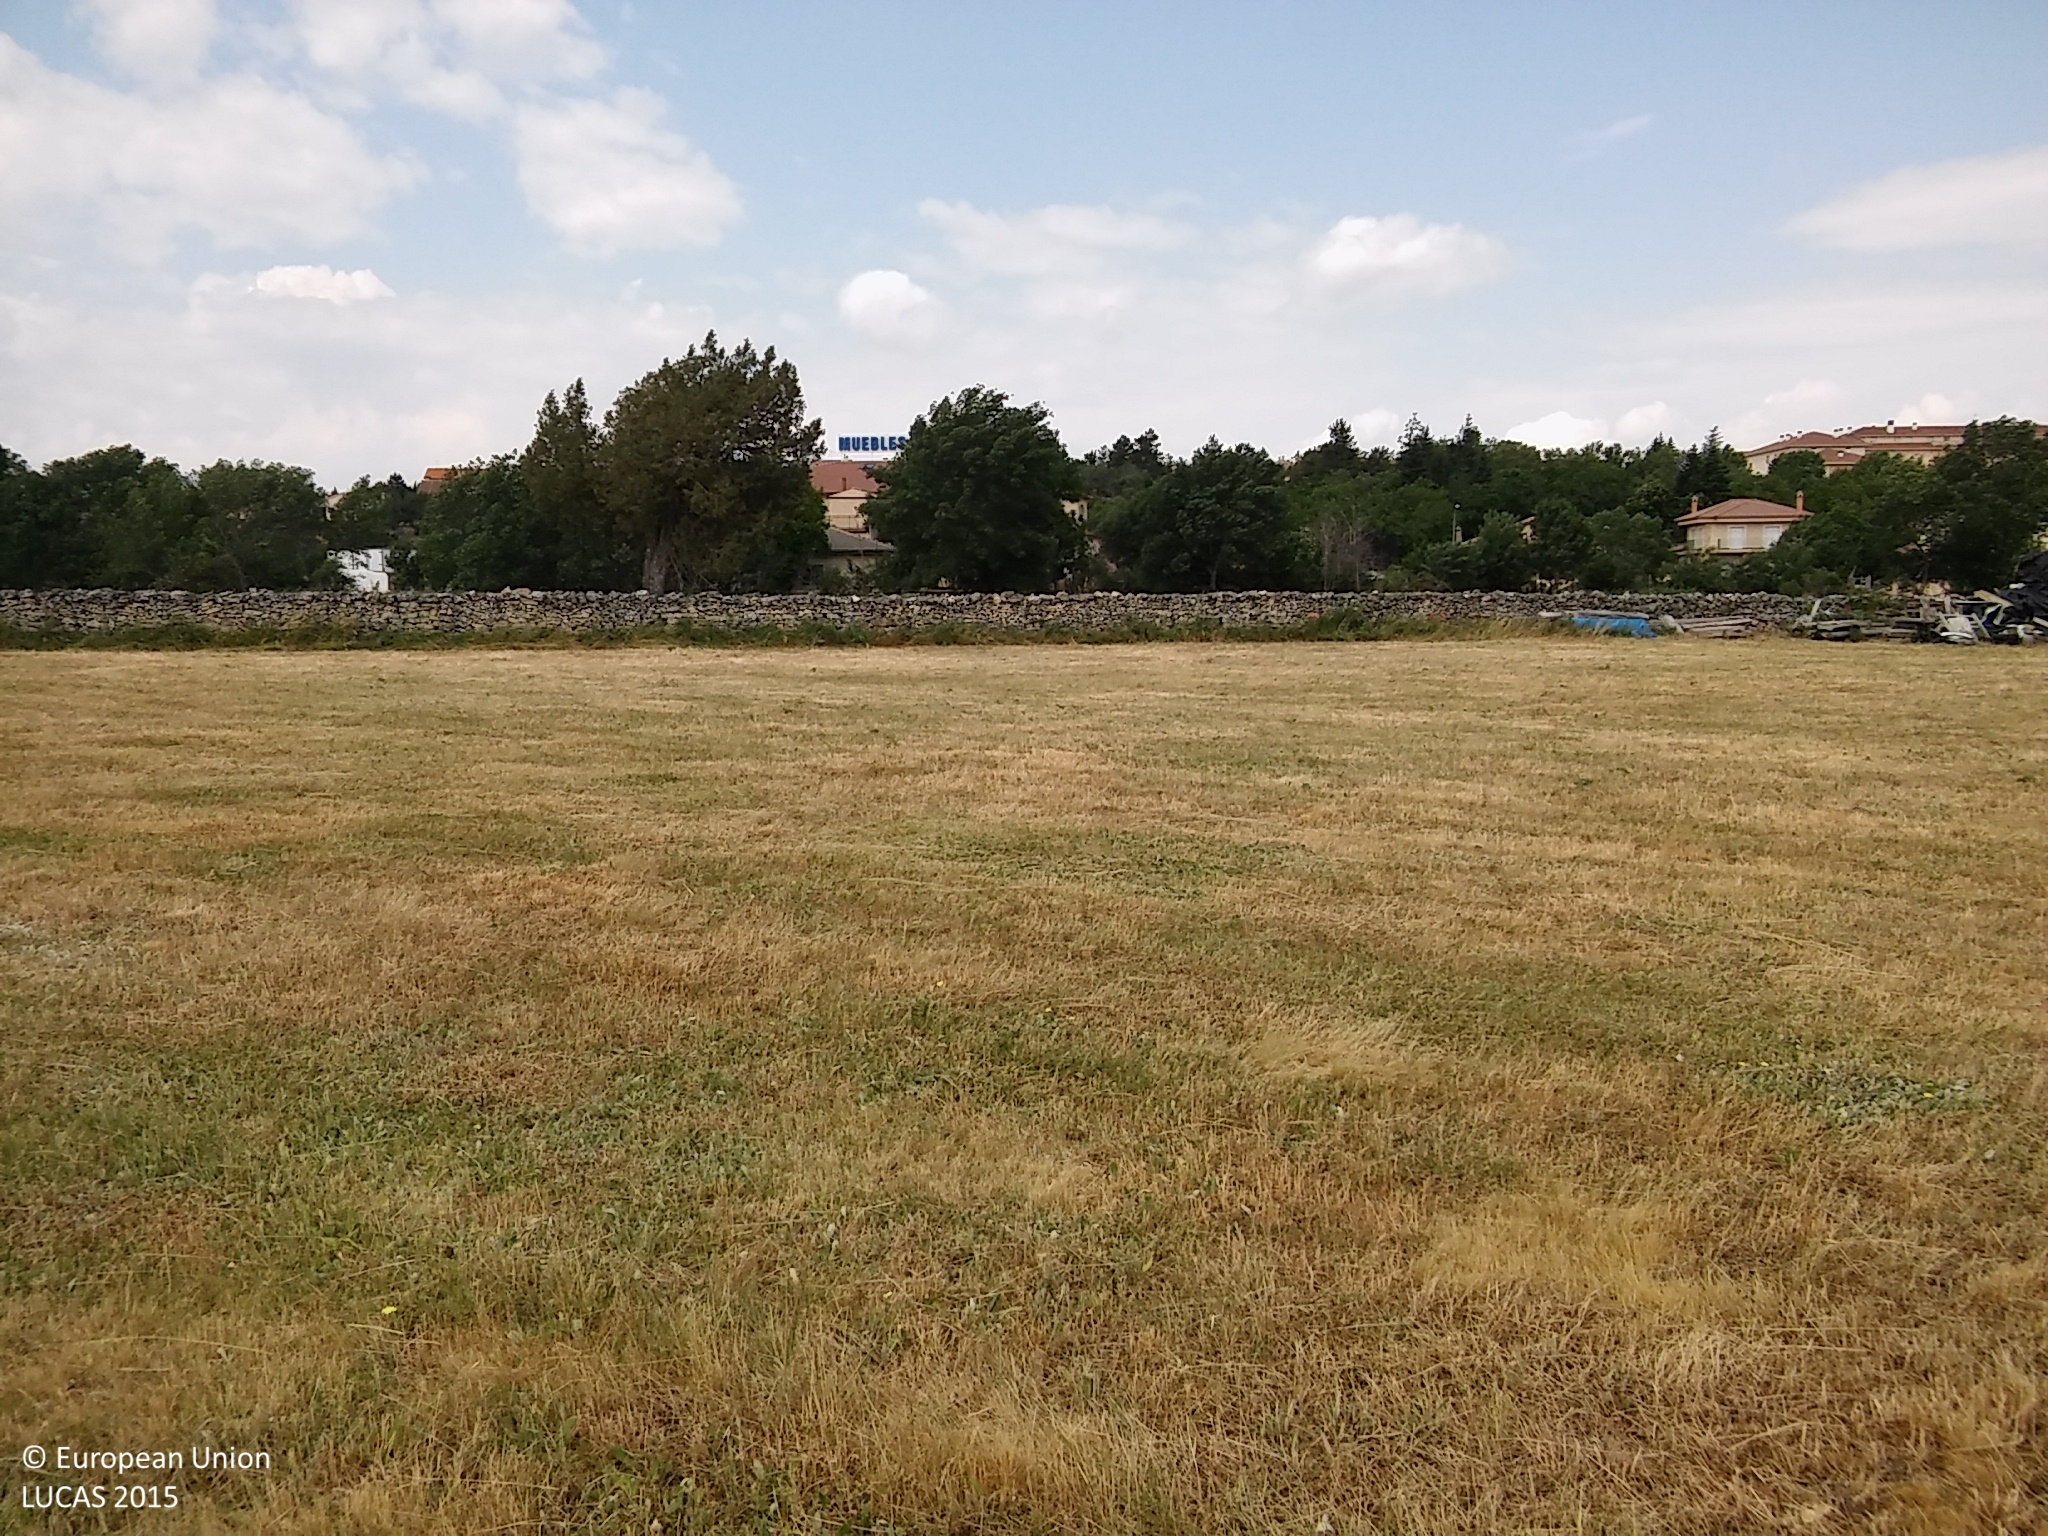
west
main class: Grassland
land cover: Grassland without tree/shrub cover
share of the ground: > 75 %
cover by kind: herbaceous plants 100 %
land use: Agriculture (excluding fallow land and kitchen gardens)
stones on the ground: 10 - 25 %
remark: Harvested field
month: June
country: ES
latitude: 41.1345
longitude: -3.6864
